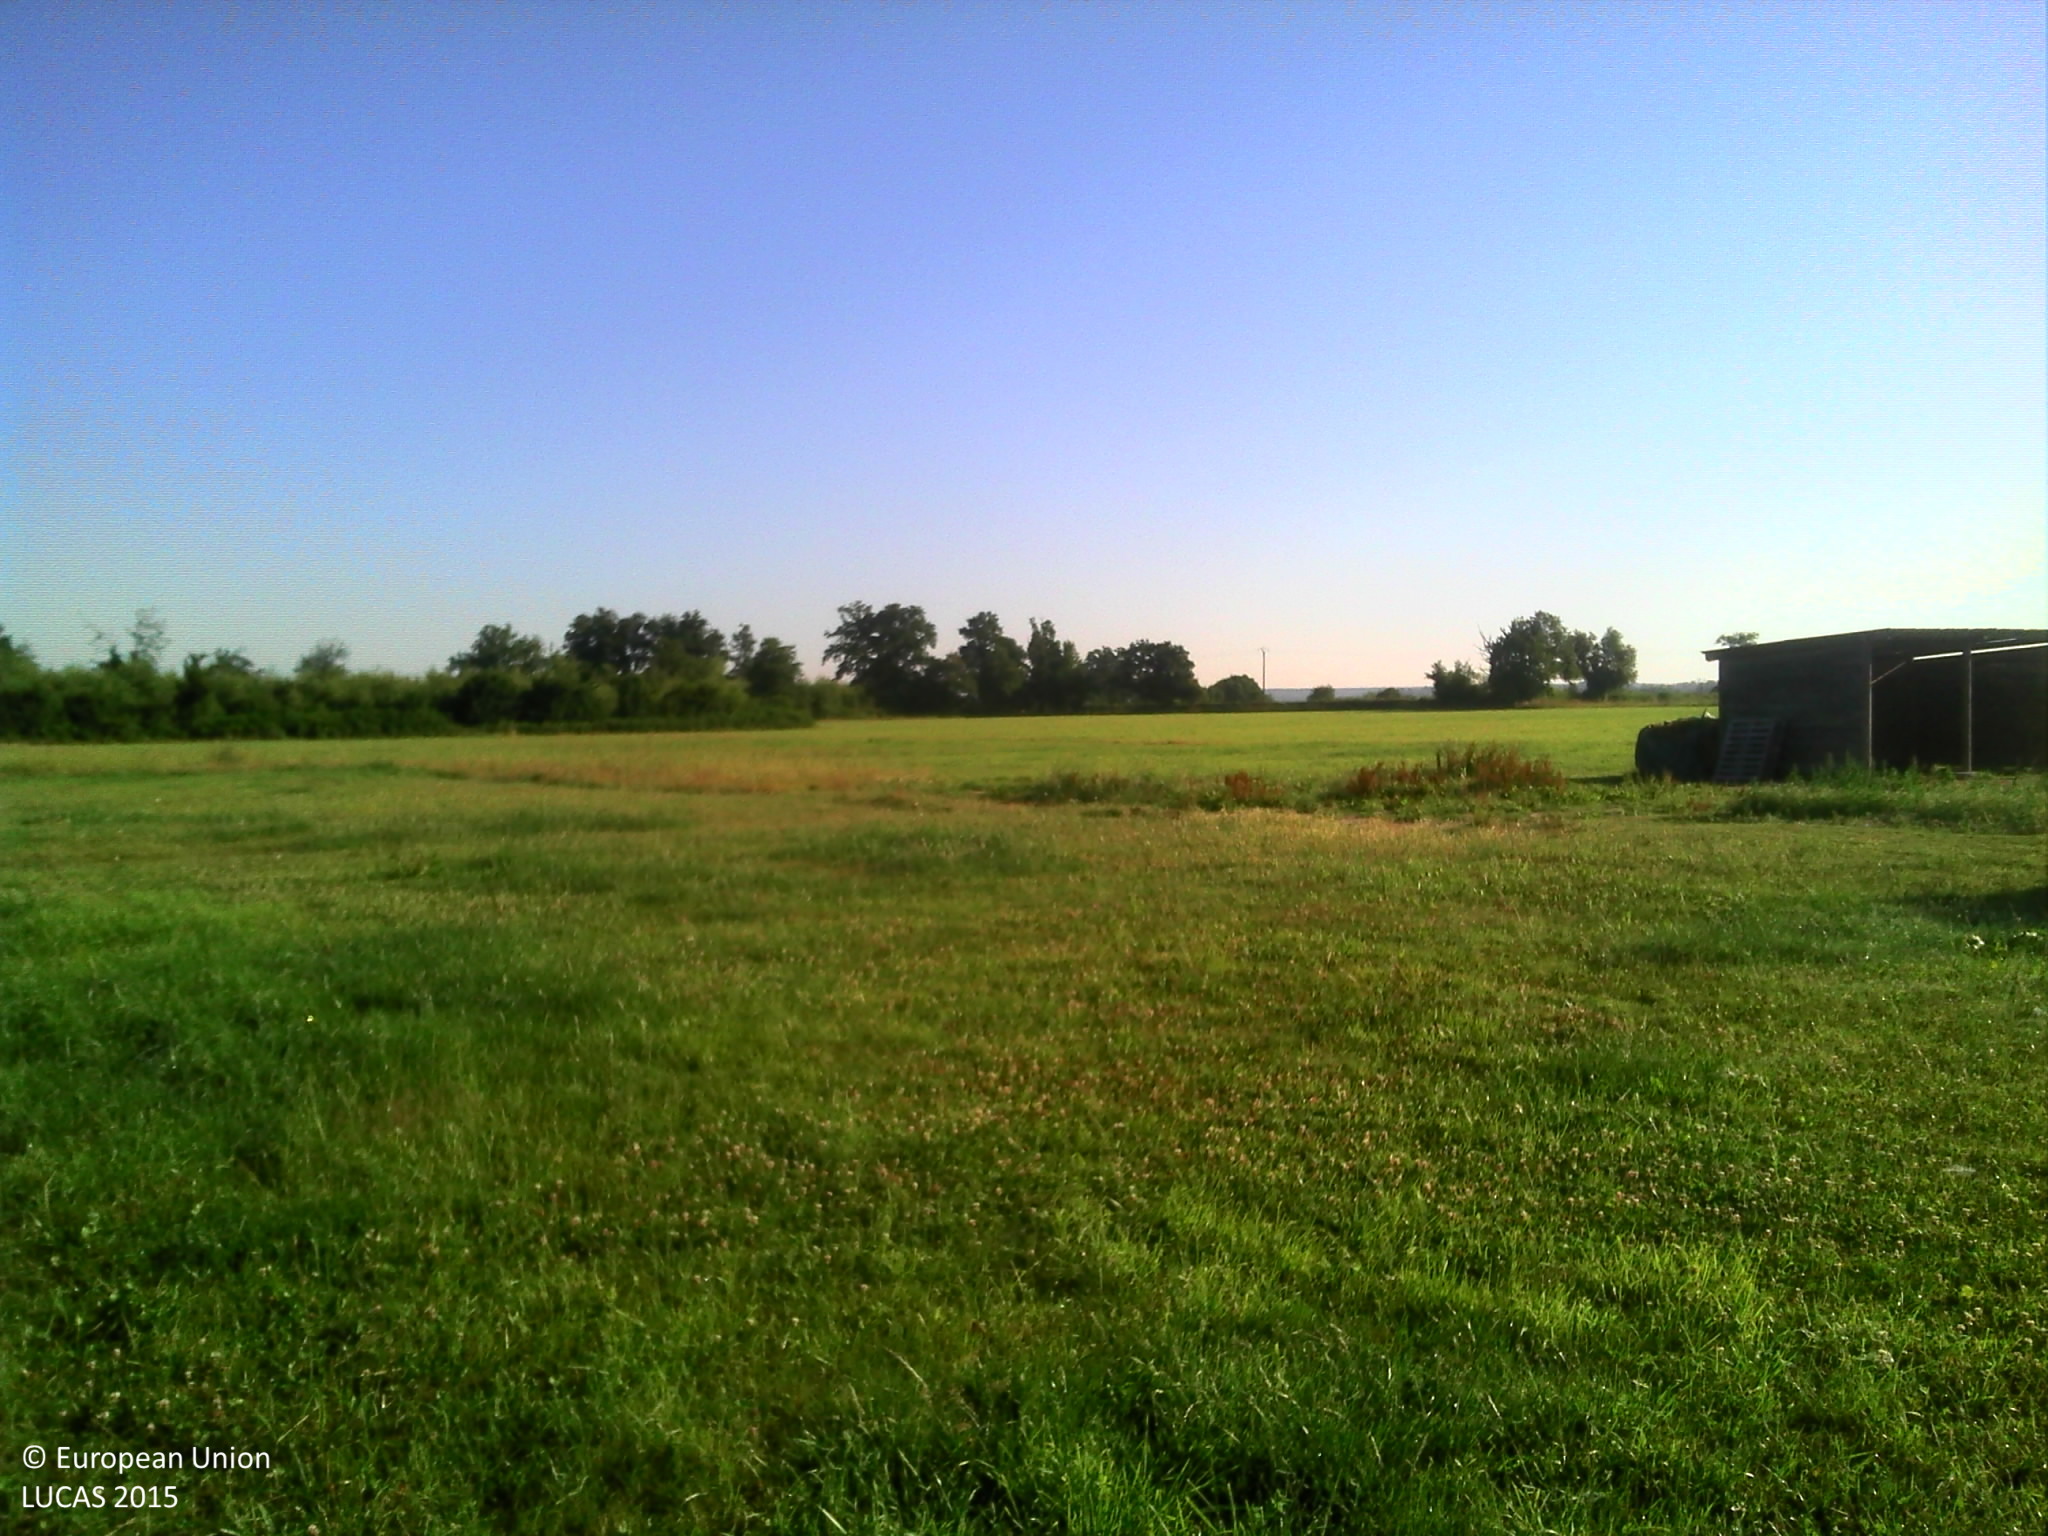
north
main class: Grassland
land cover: Grassland without tree/shrub cover
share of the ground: > 75 %
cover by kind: herbaceous plants 100 %
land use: Agriculture (excluding fallow land and kitchen gardens)
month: June
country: FR
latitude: 46.4579
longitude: 4.0763
